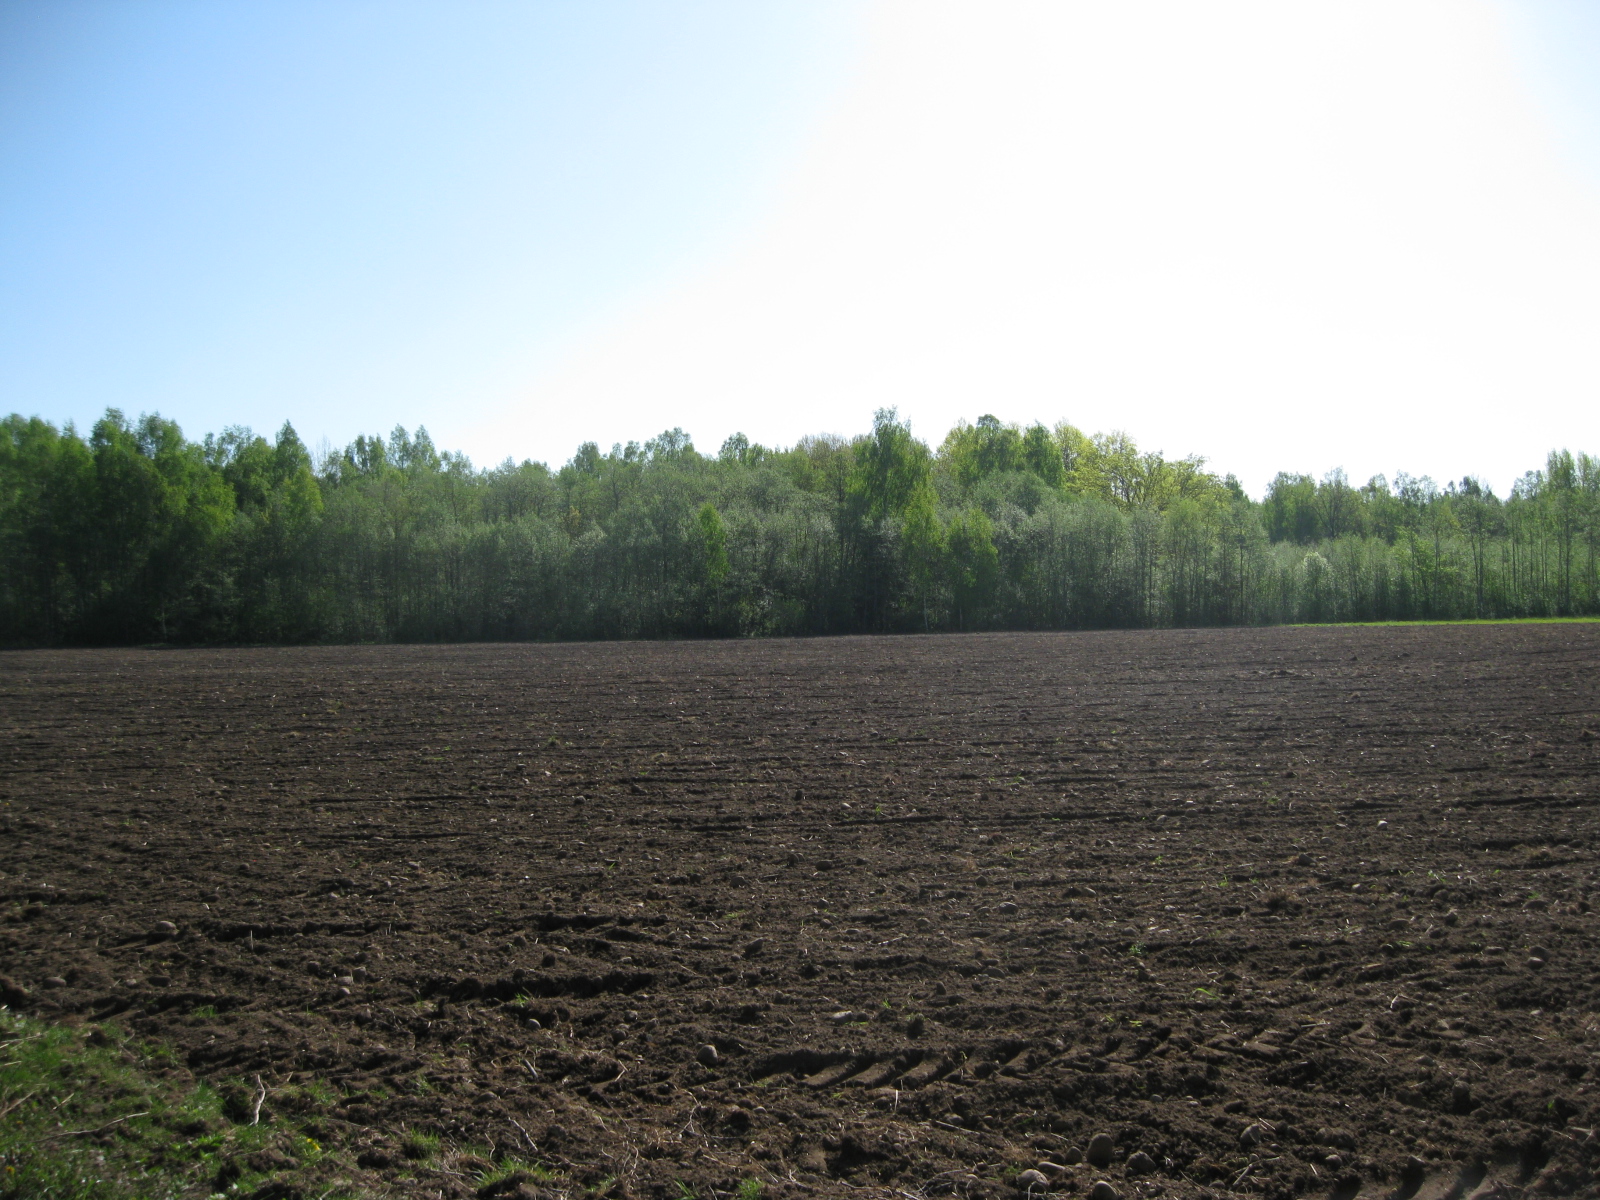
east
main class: Grassland
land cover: Spontaneously vegetated surfaces
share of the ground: 50 - 75 %
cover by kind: herbaceous plants 60 %, unconsolidated bare surface 40 %
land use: Agriculture (excluding fallow land and kitchen gardens)
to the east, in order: Spontaneously vegetated surfaces; Oats; Broadleaved woodland; Ditches and canals; Broadleaved woodland
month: May
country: LT
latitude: 56.0234
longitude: 24.9168
